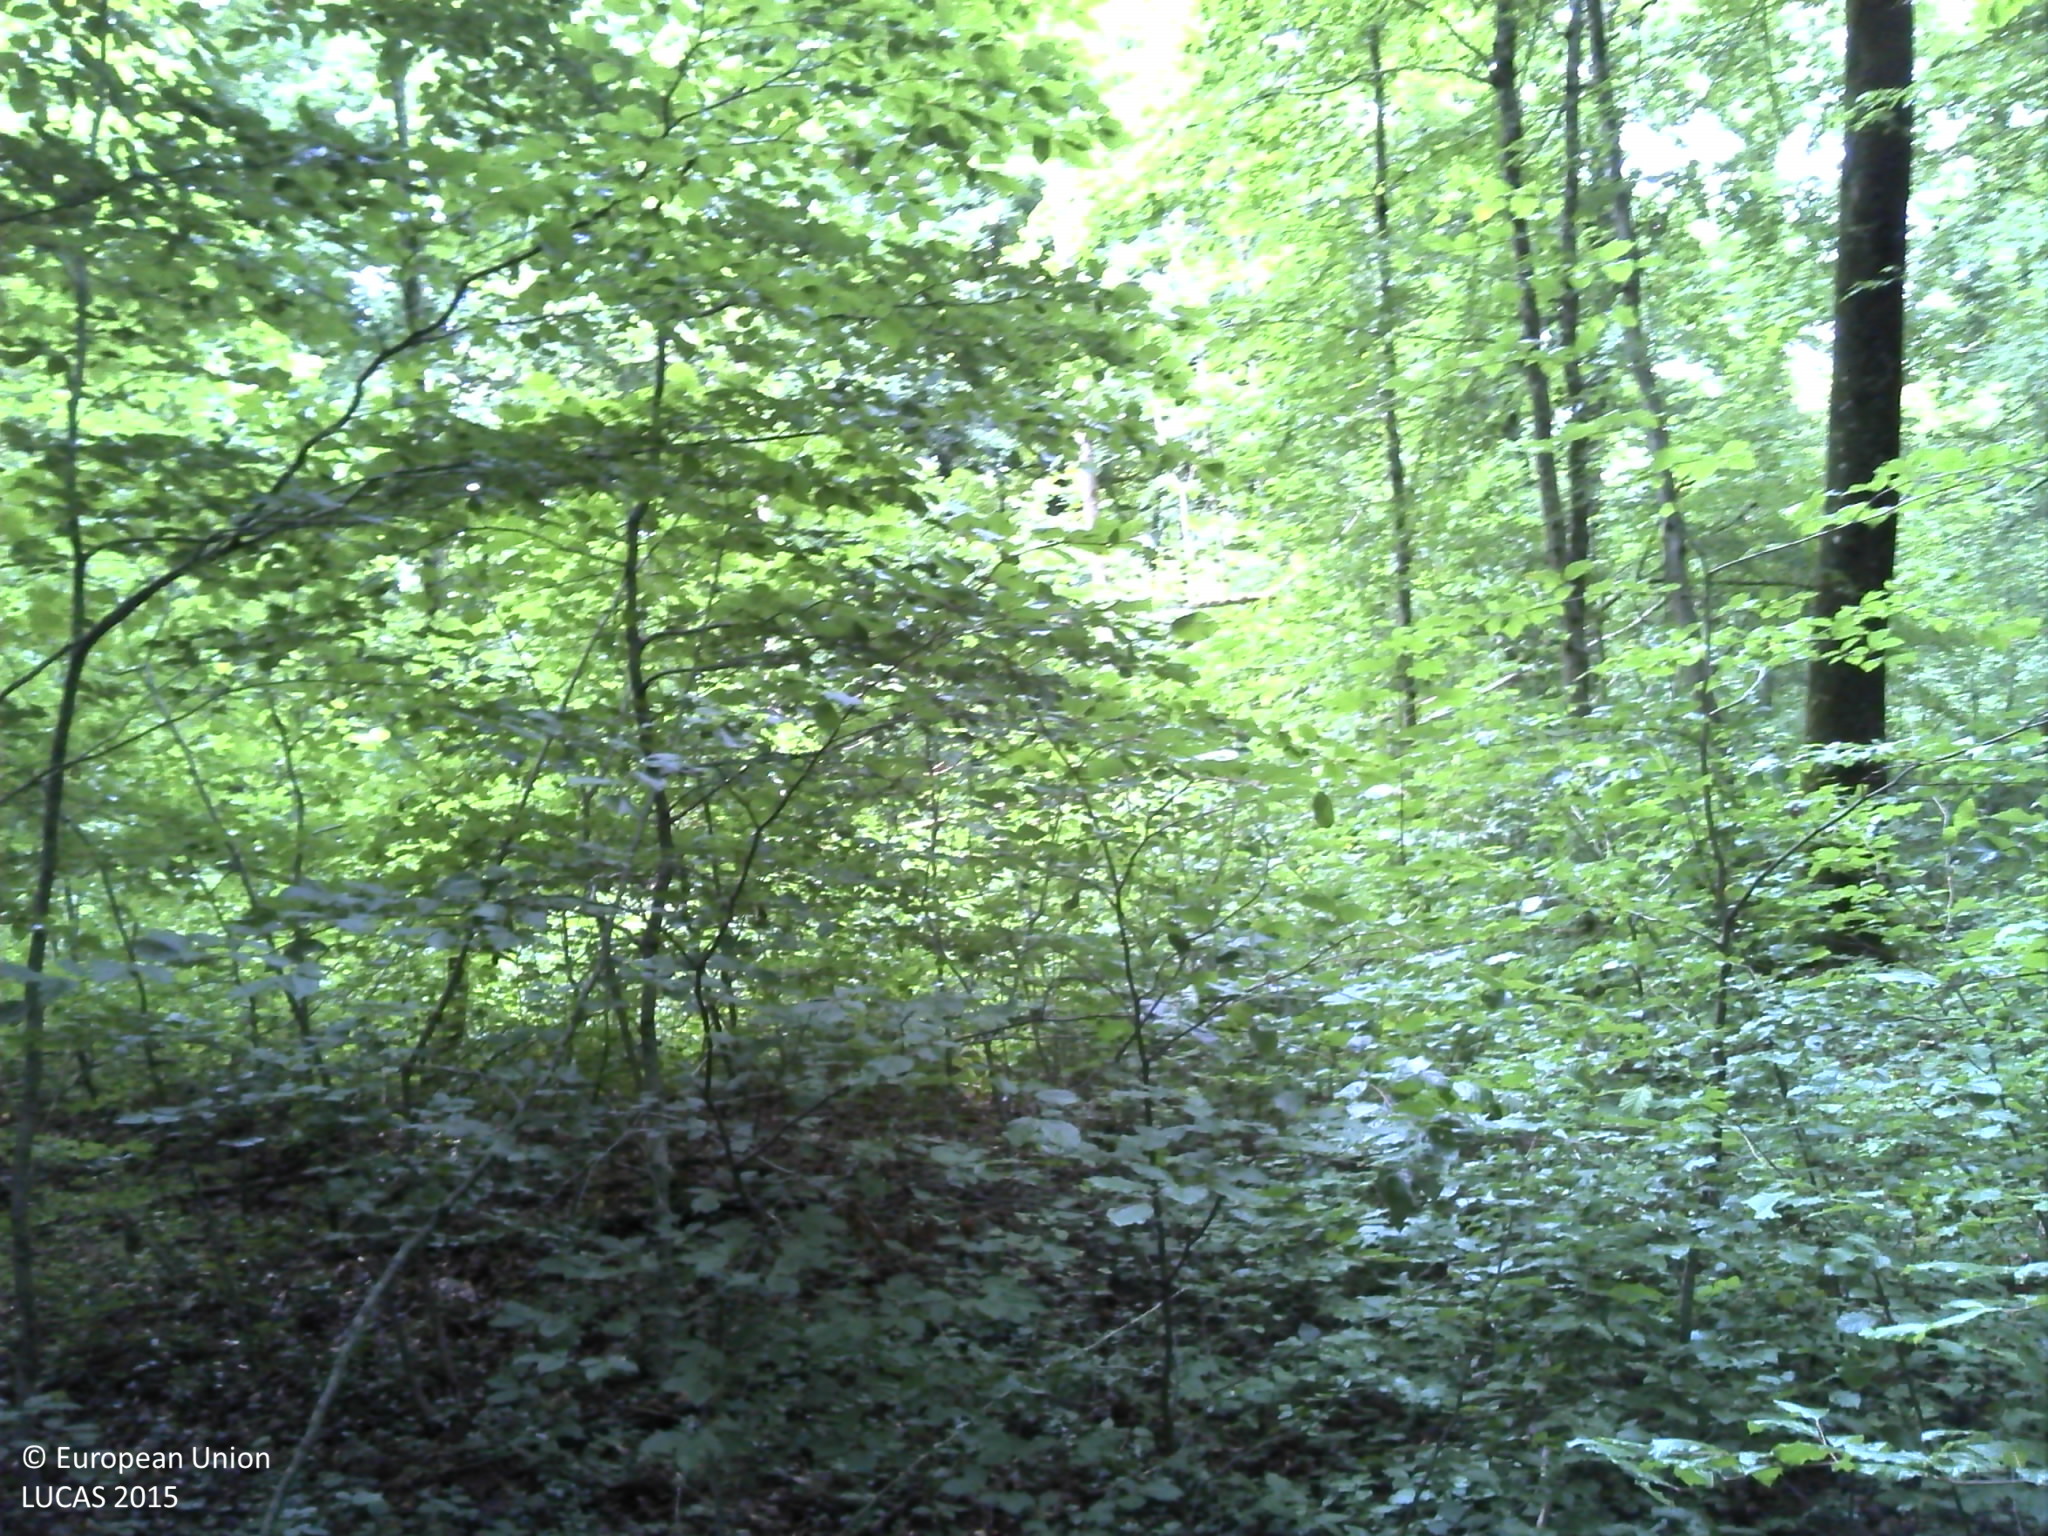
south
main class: Woodland
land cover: Broadleaved woodland
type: beech forest
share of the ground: > 75 %
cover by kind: broadleaved forest trees 70 %, herbaceous plants 20 %, lichens and mosses 5 %, consolidated bare surface 5 %
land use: Forestry
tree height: > 5 m
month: June
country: FR
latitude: 49.6487
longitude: 4.7476
